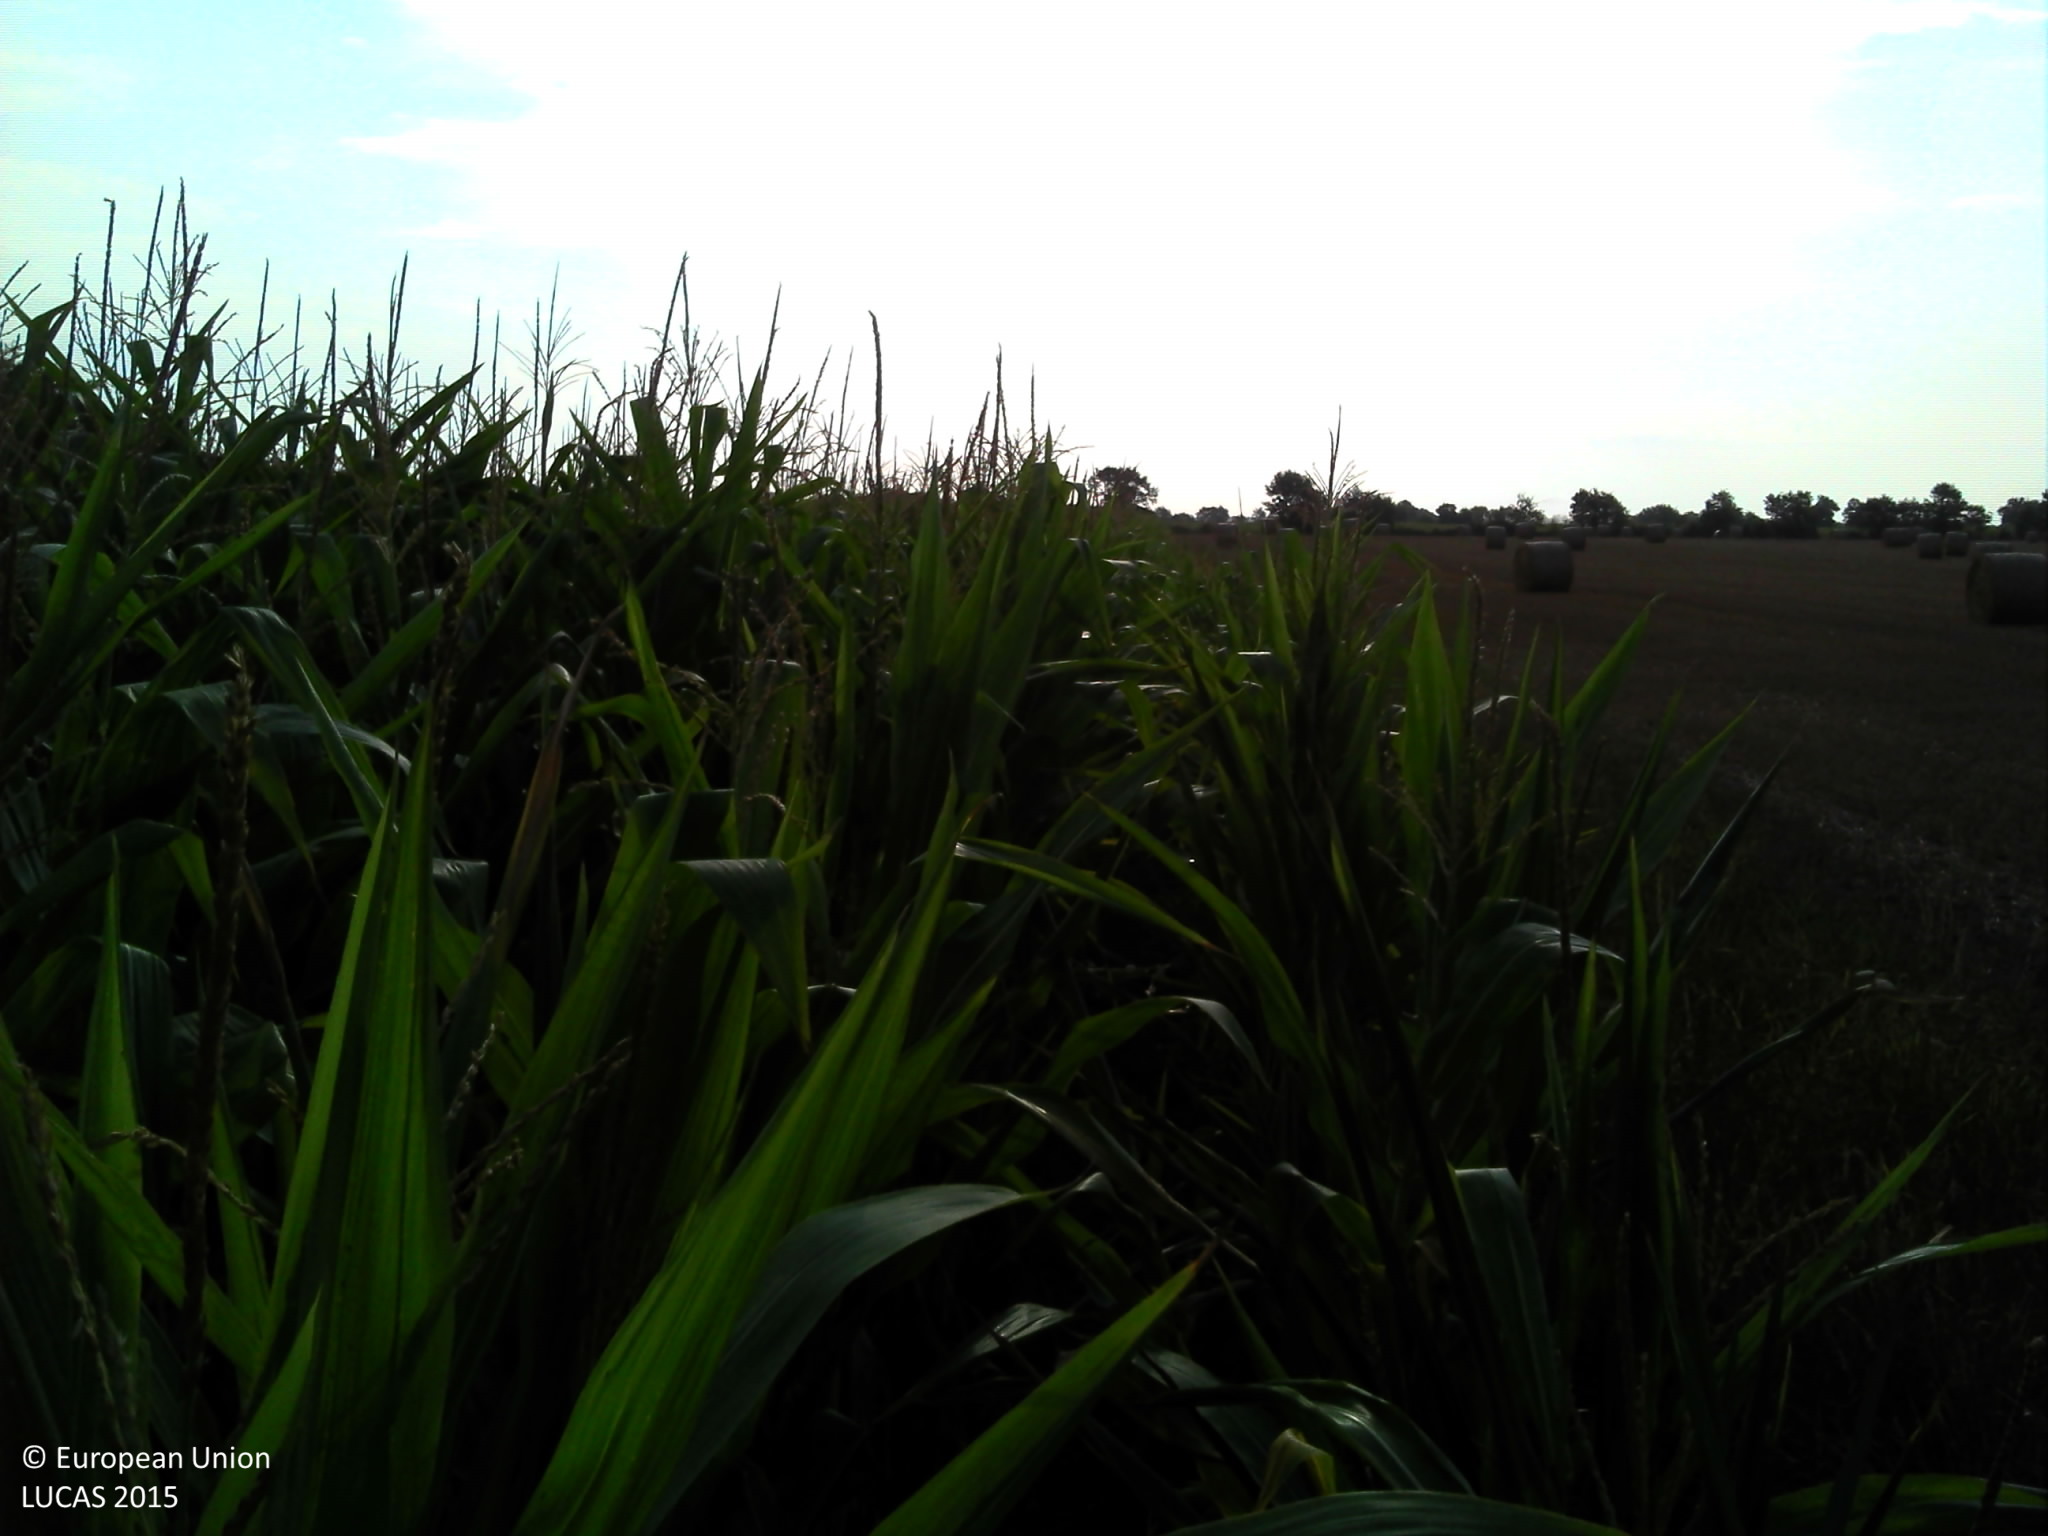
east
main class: Cropland
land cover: Maize
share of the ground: > 75 %
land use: Agriculture (excluding fallow land and kitchen gardens)
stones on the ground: < 10 %
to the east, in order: Maize
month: August
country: FR
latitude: 46.9618
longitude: -1.6995
